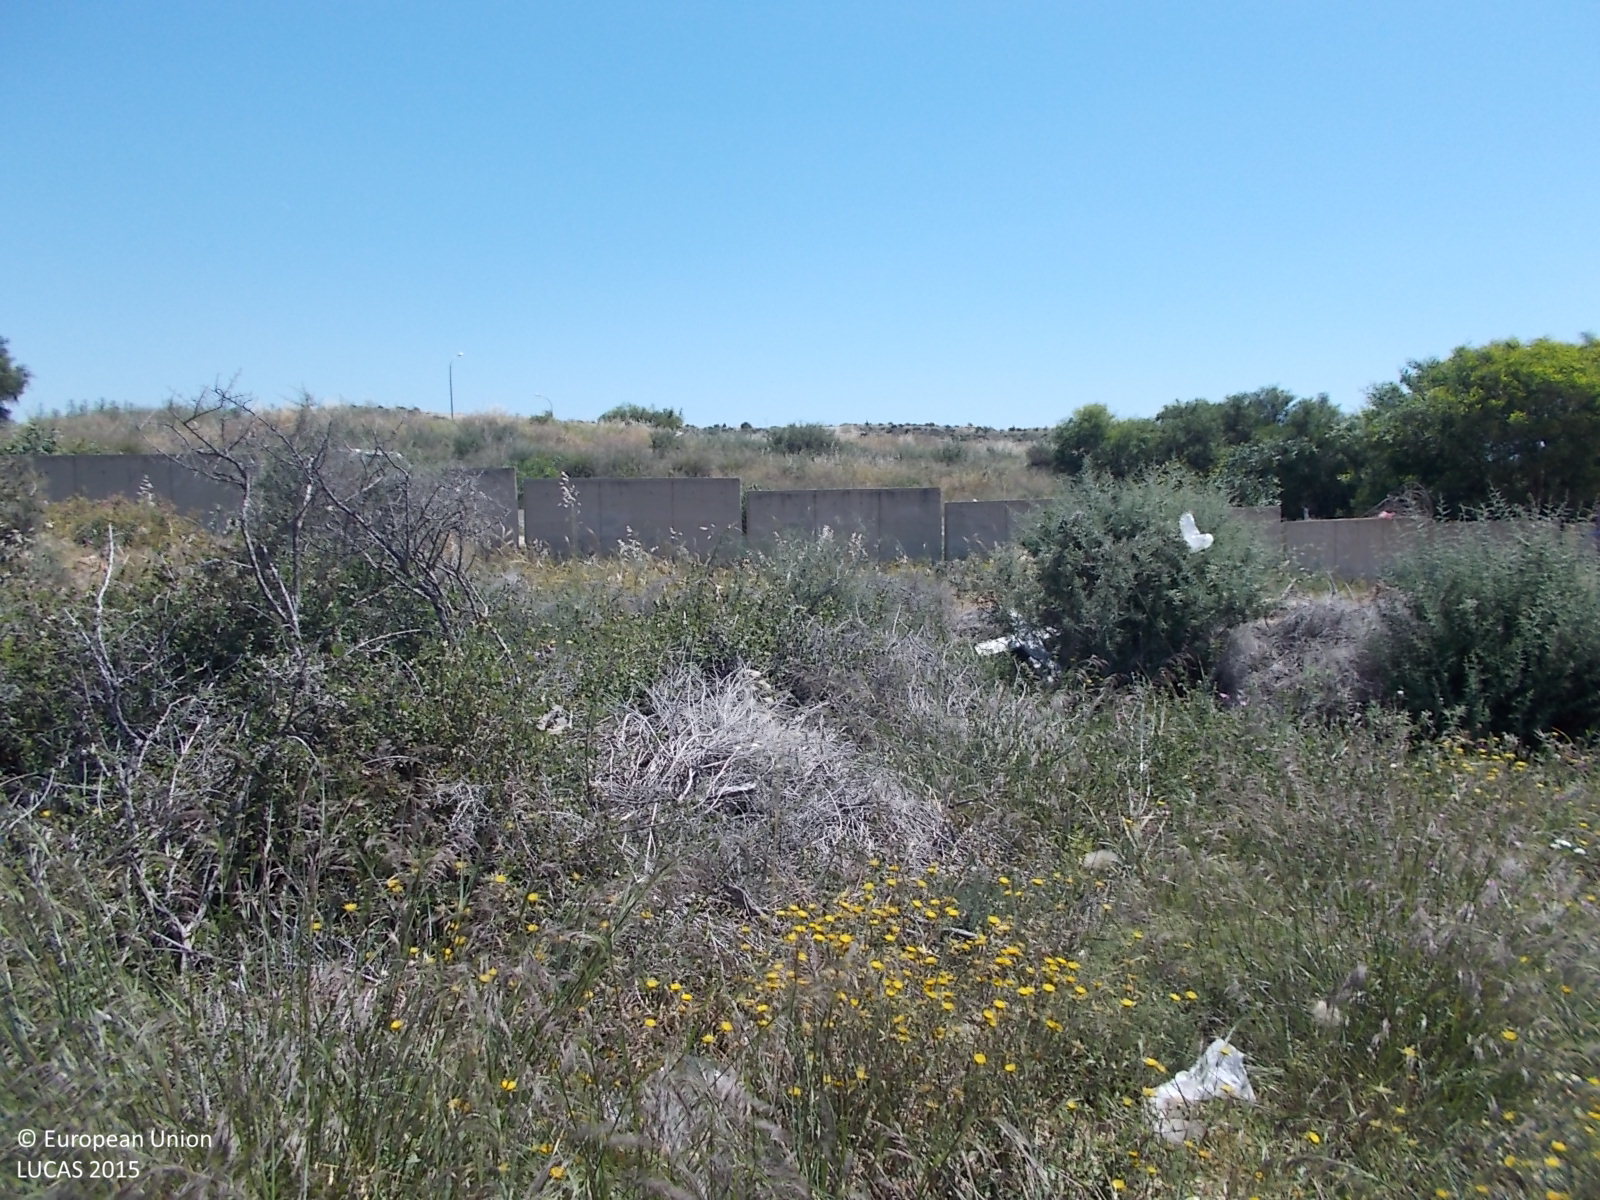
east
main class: Shrubland
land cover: Shrubland without tree cover
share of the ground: 50 - 75 %
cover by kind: shrubs 50 %, unconsolidated bare surface 30 %, herbaceous plants 20 %
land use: Semi-natural and natural areas not in use
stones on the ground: < 10 %
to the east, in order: Shrubland without tree cover; Artificial constructions; Other bare soil; Paved roads, cycling and walking lanes; Spontaneously vegetated surfaces; Paved roads, cycling and walking lanes; Abandoned hedges; Other bare soil; Shrubland with sparse tree cover; Paved roads, cycling and walking lanes; Shrubland without tree cover; Spontaneously vegetated surfaces; Paved roads, cycling and walking lanes; Shrubland with sparse tree cover; Paved roads, cycling and walking lanes; Shrubland with sparse tree cover
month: April
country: CY
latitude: 34.7208
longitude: 33.0658
